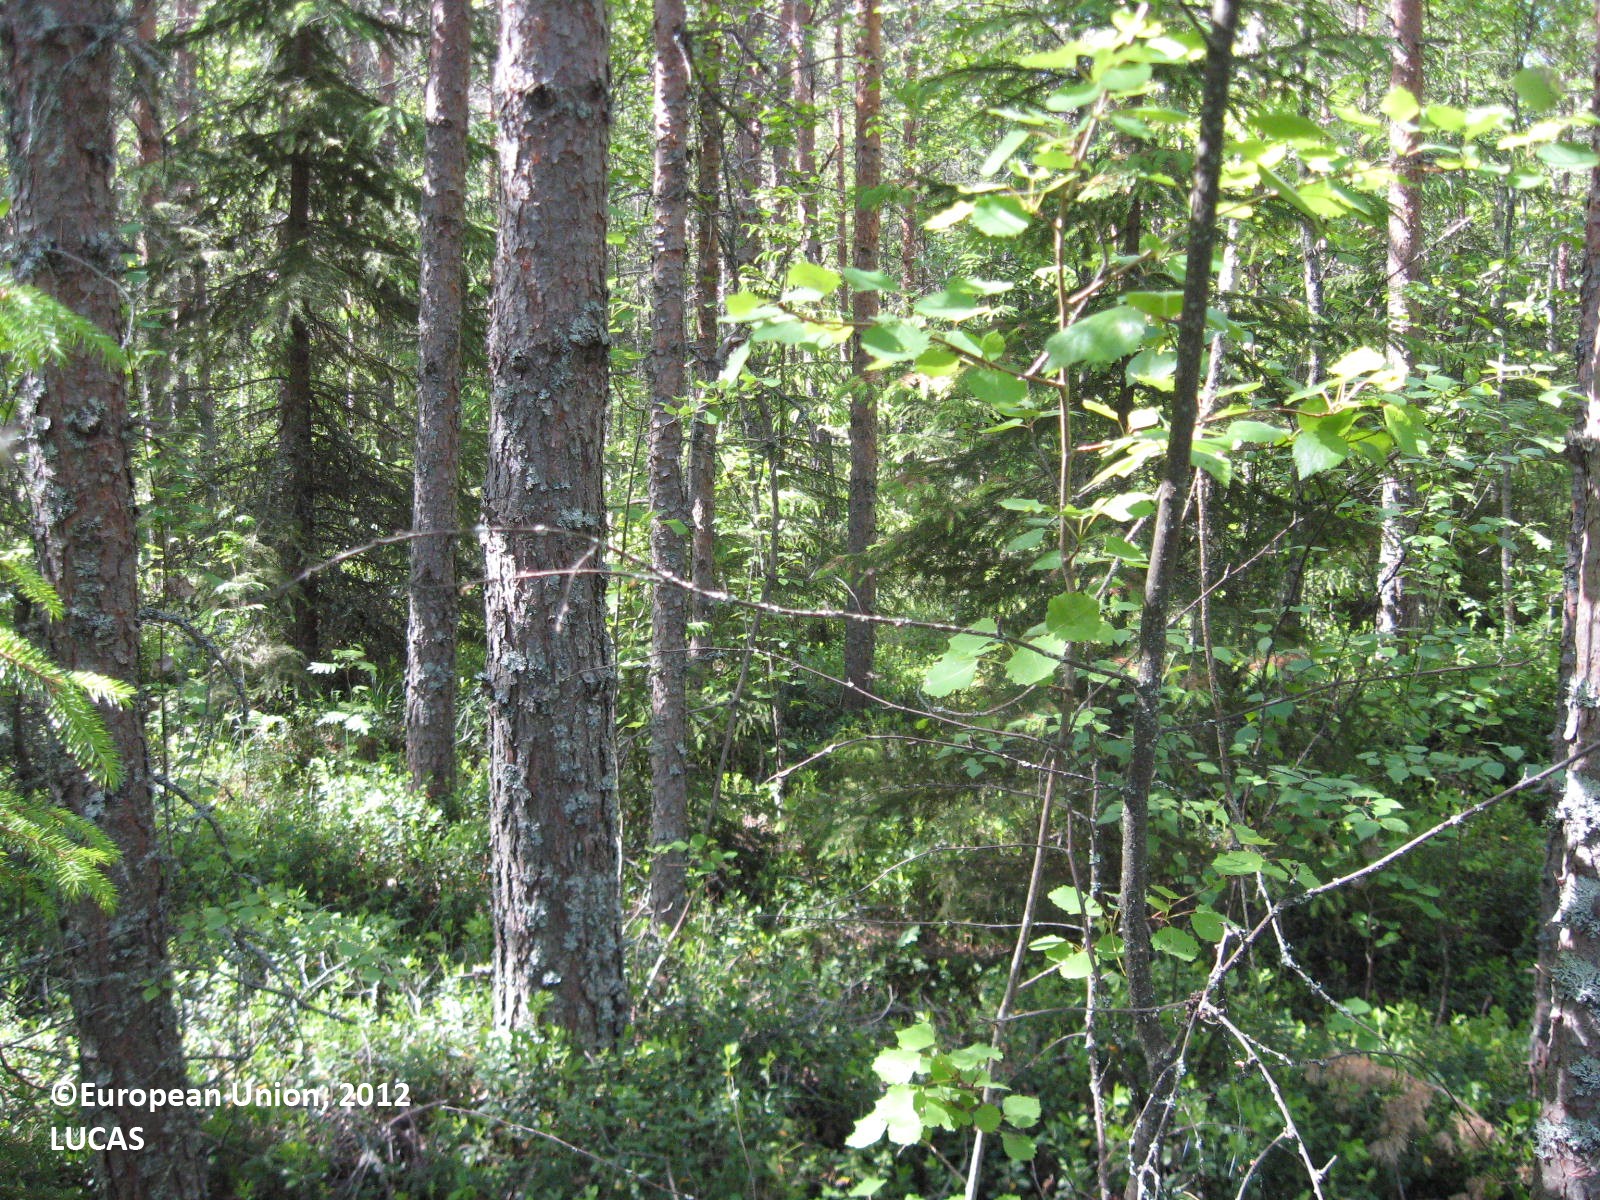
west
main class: Woodland
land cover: Pine dominated mixed woodland
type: boreal forest
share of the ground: > 75 %
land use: Forestry
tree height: > 5 m
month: June
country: FI
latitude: 62.6987
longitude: 21.5135
